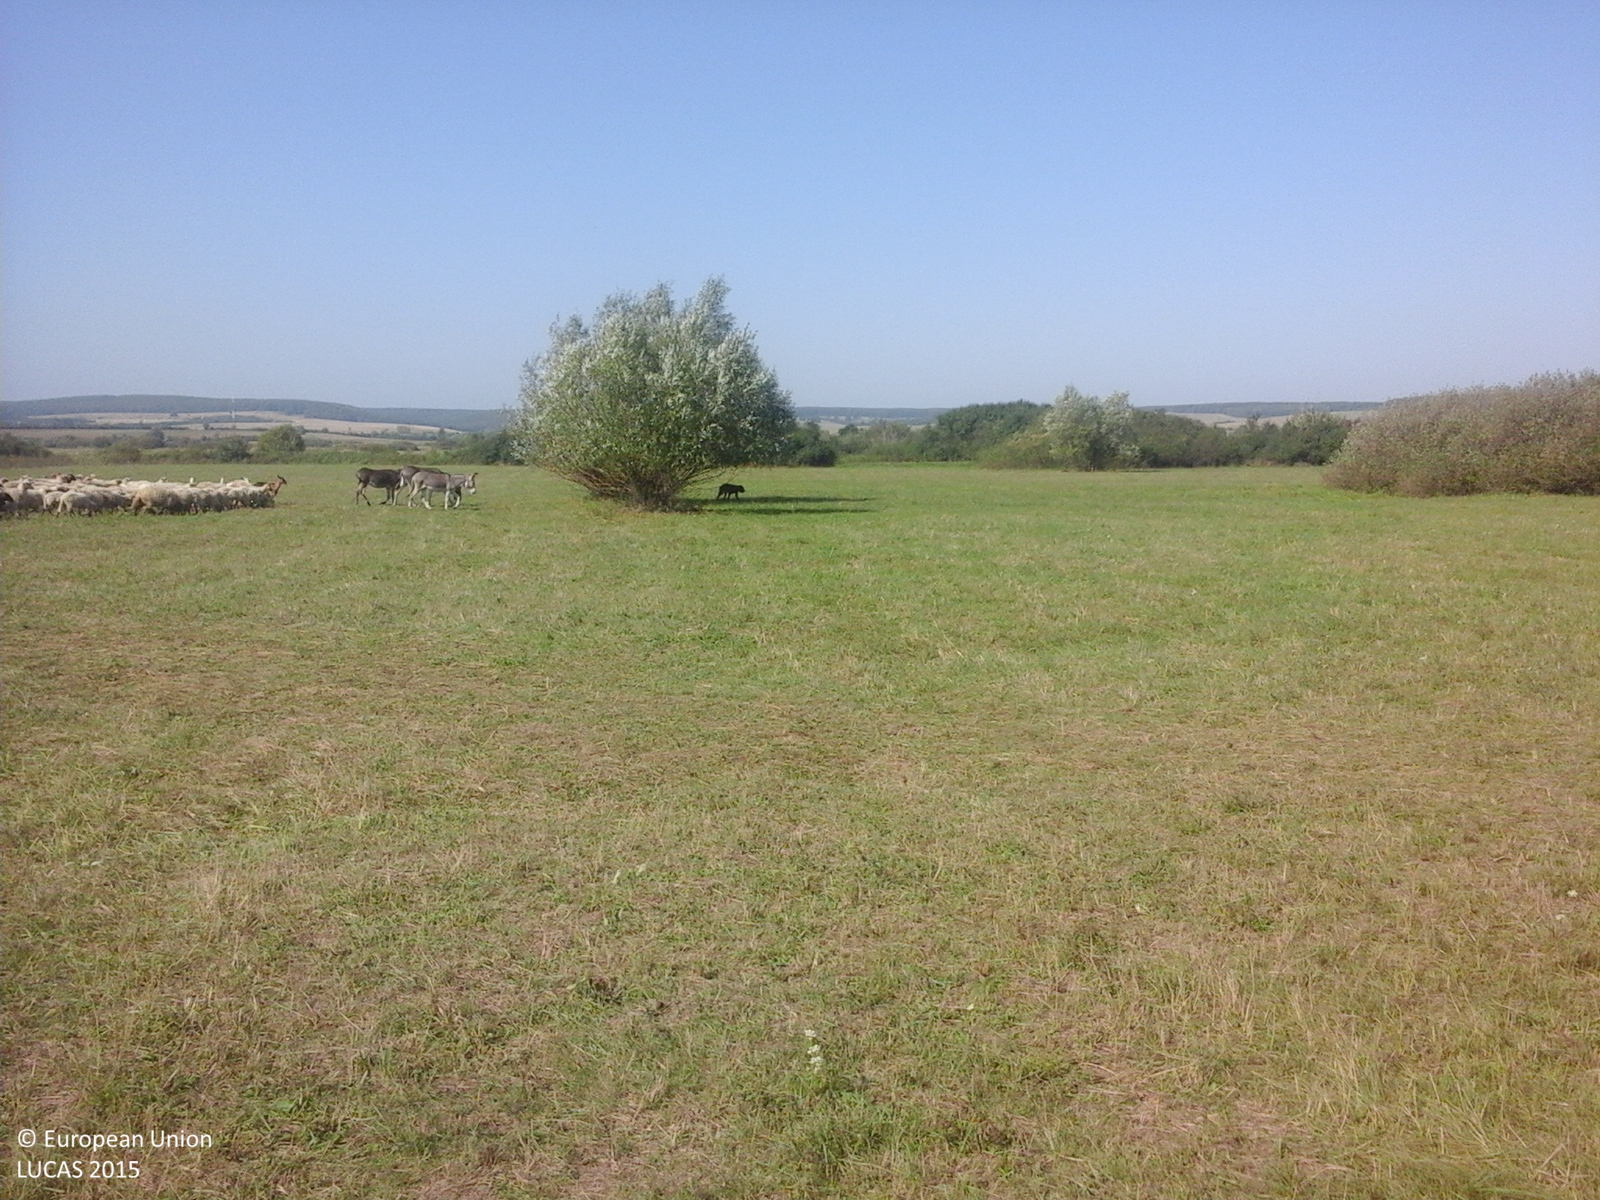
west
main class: Grassland
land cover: Grassland without tree/shrub cover
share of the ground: > 75 %
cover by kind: herbaceous plants 100 %
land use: Agriculture (excluding fallow land and kitchen gardens)
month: September
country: RO
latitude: 47.4222
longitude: 22.7731
